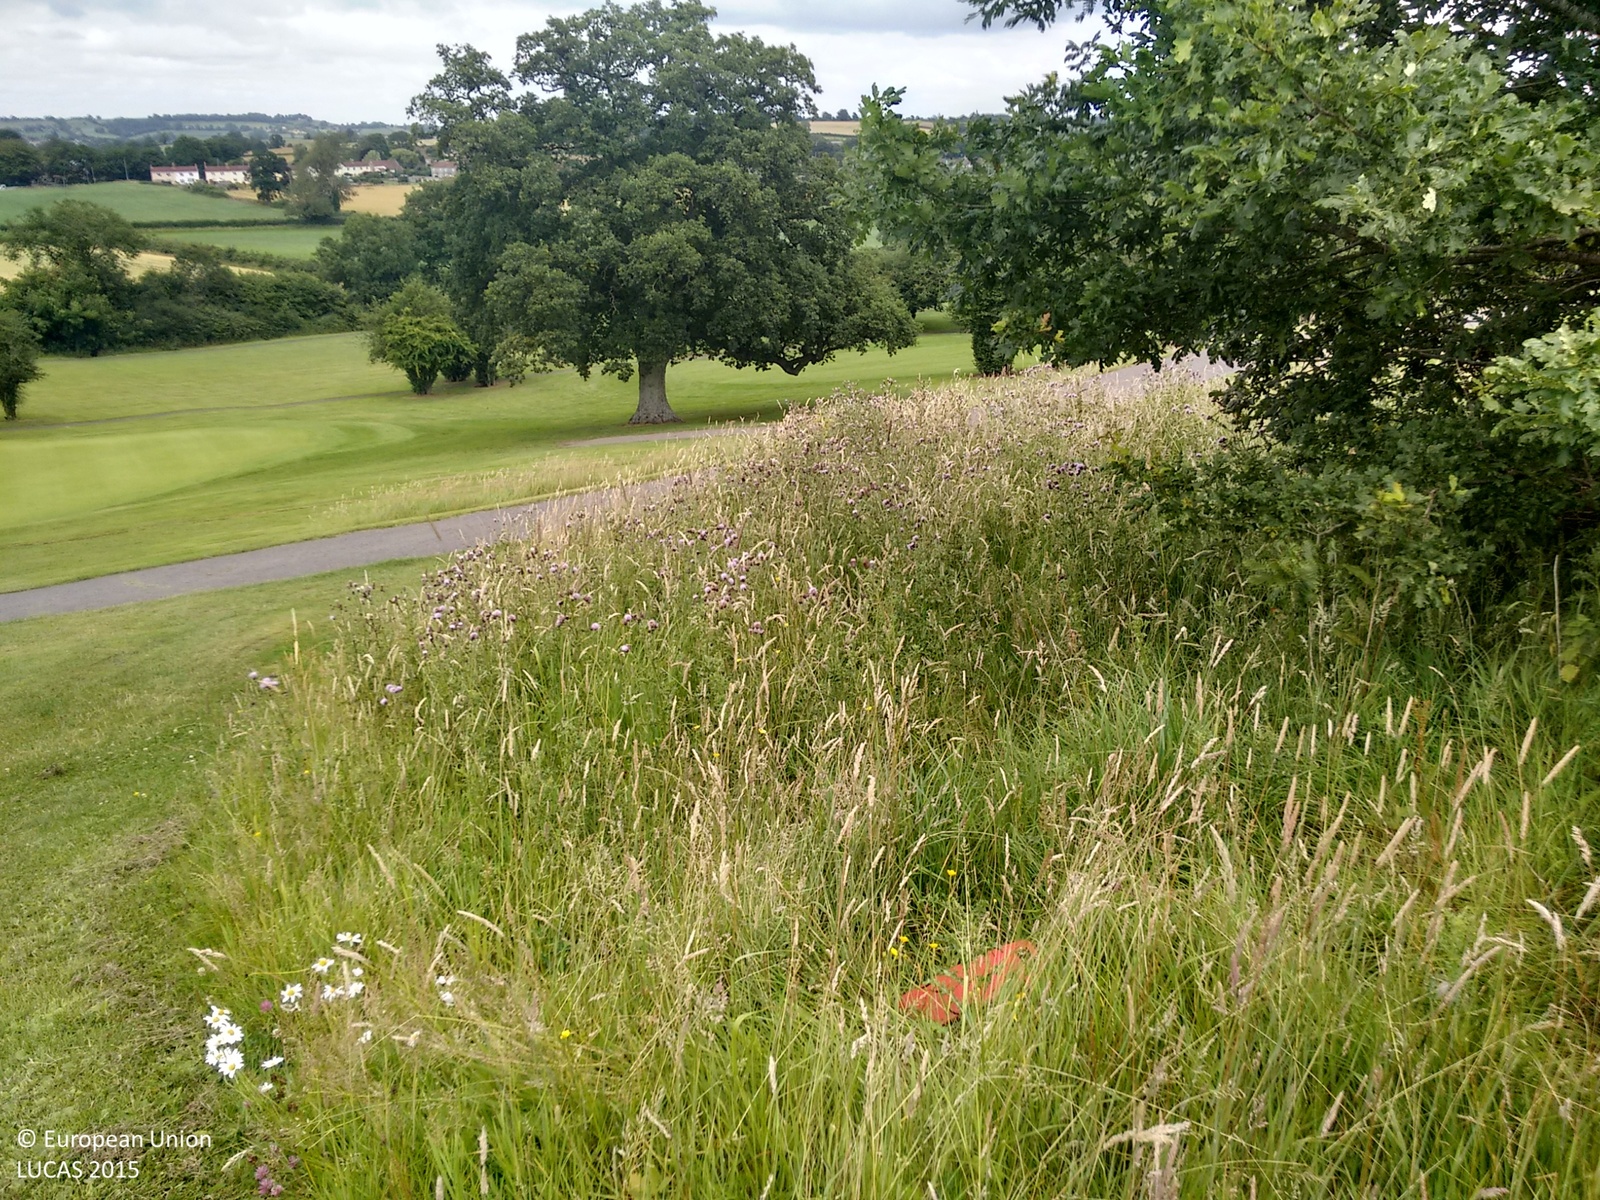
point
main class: Grassland
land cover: Grassland without tree/shrub cover
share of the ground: > 75 %
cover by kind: herbaceous plants 100 %
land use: Sport
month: July
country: GB
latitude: 51.2918
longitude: -2.5284
